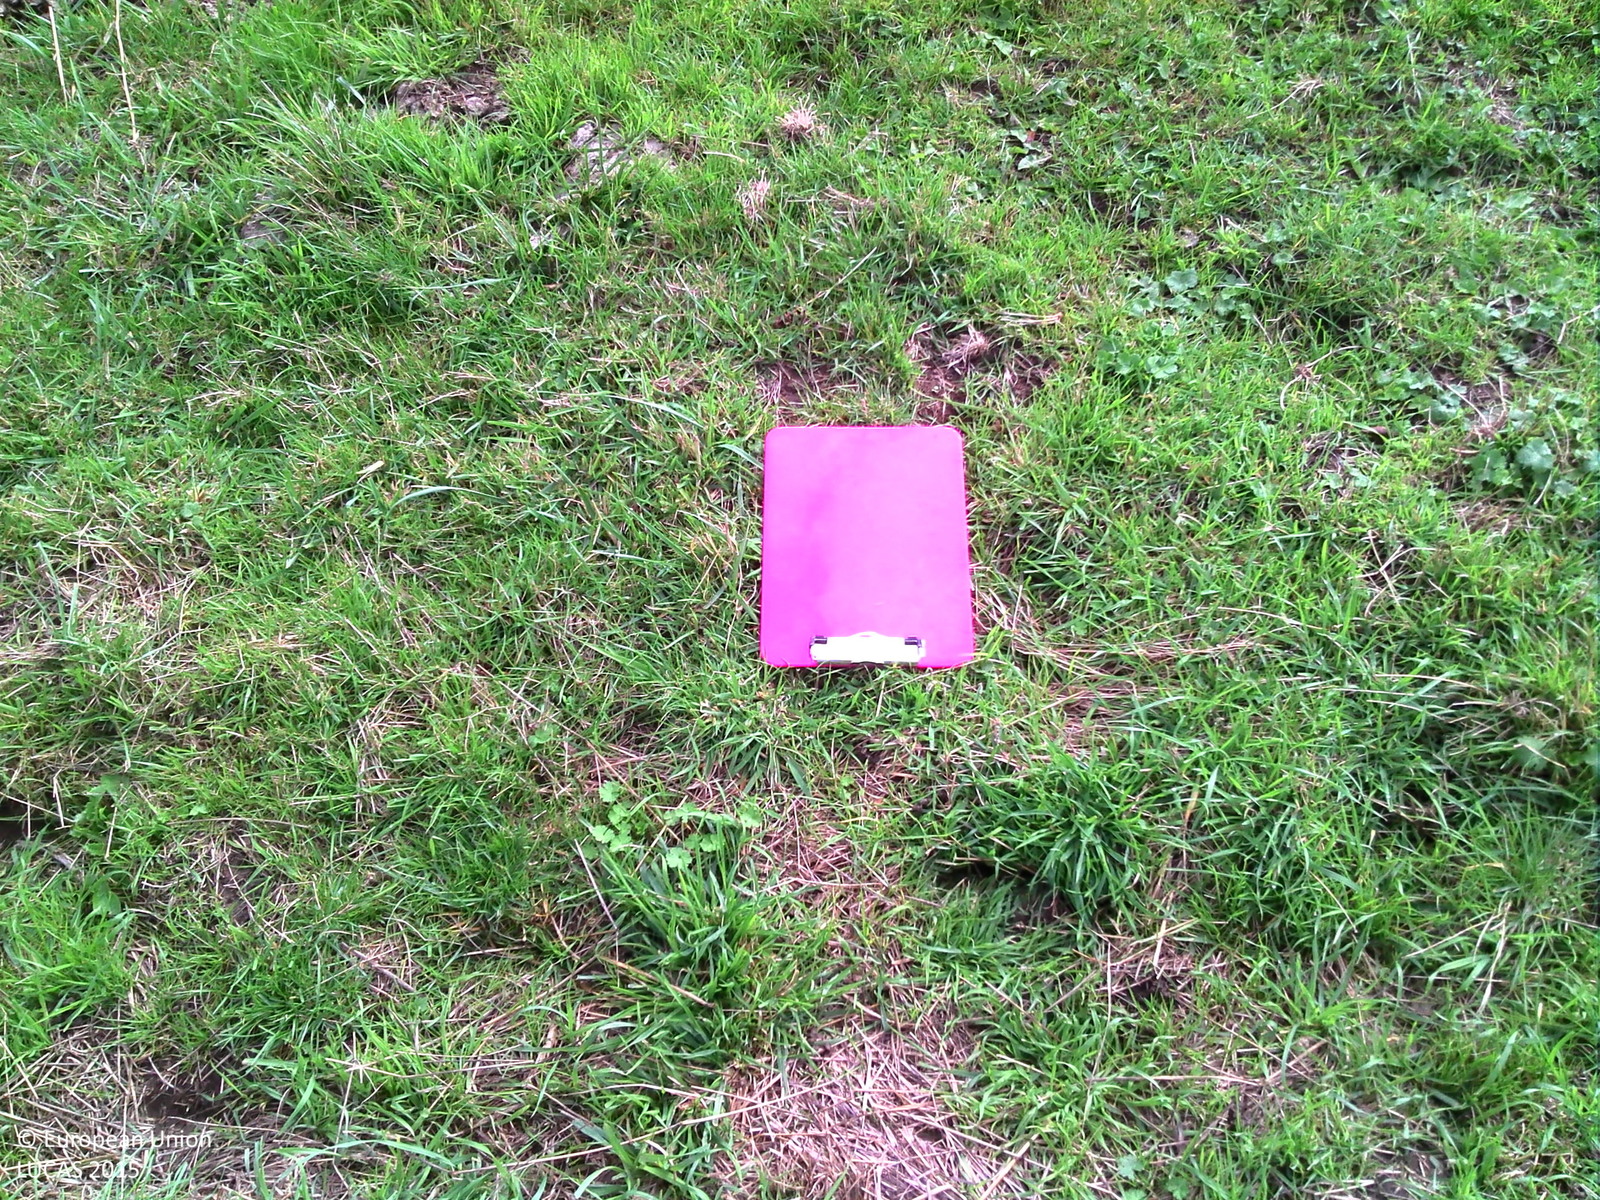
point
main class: Grassland
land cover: Grassland without tree/shrub cover
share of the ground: > 75 %
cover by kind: herbaceous plants 100 %
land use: Agriculture (excluding fallow land and kitchen gardens)
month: September
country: FR
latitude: 48.3816
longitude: 4.6373
